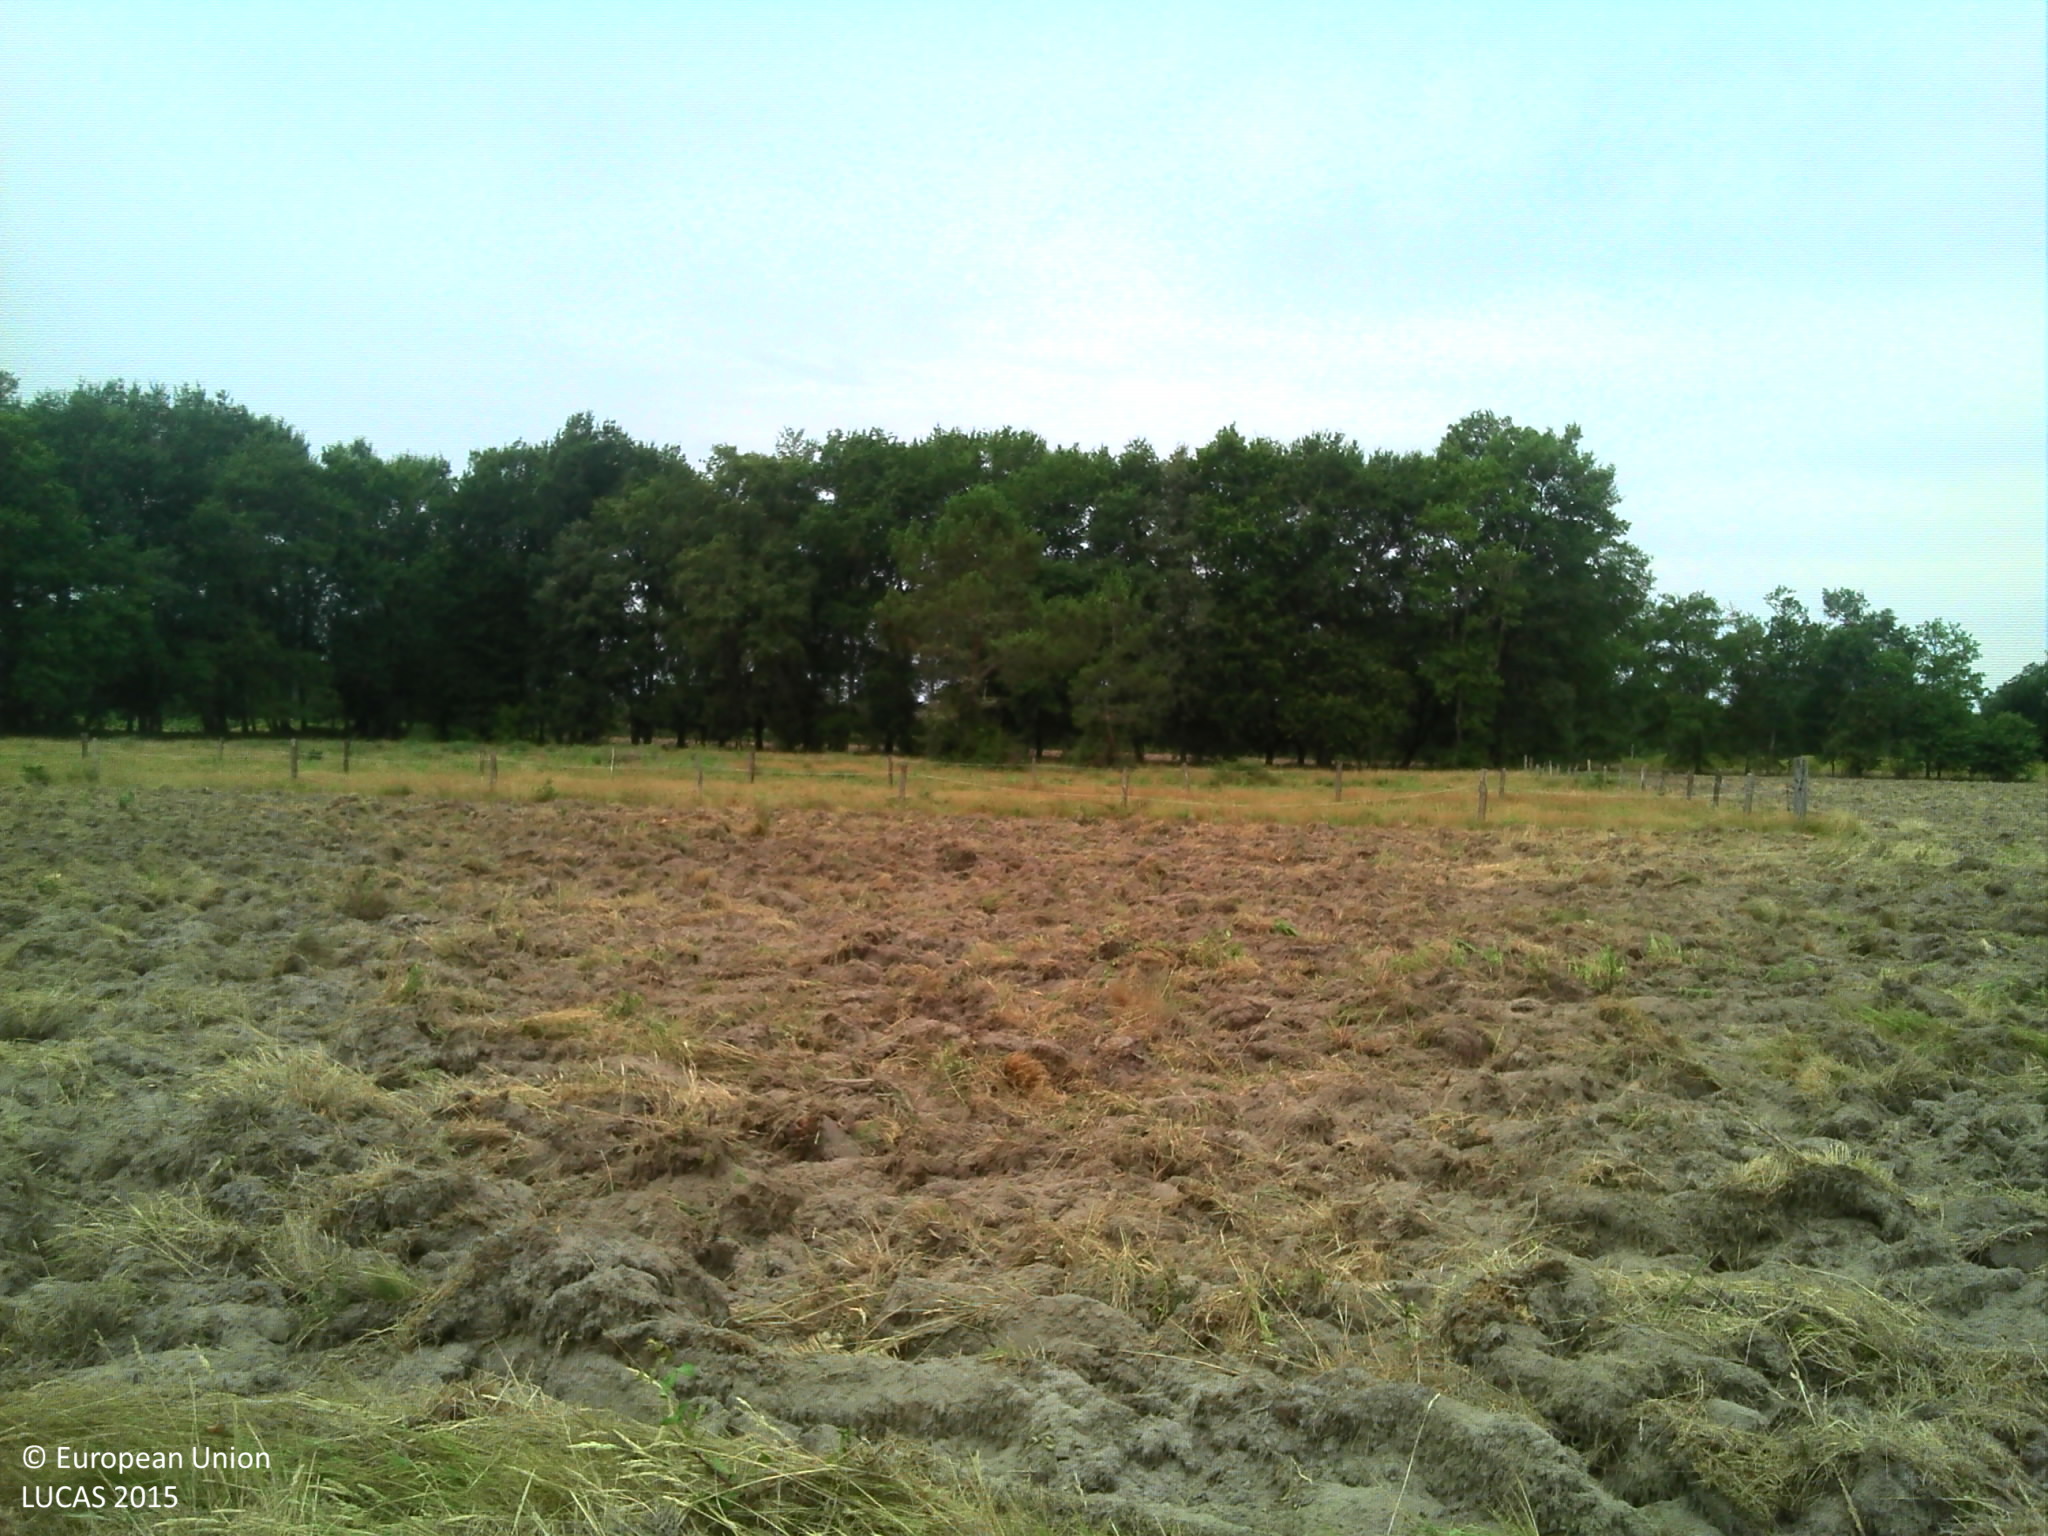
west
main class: Grassland
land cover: Spontaneously vegetated surfaces
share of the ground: 10 - 25 %
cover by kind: unconsolidated bare surface 80 %, herbaceous plants 20 %
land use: Forestry
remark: Tilled/Sowed
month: July
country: FR
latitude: 44.0848
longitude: -0.5415
